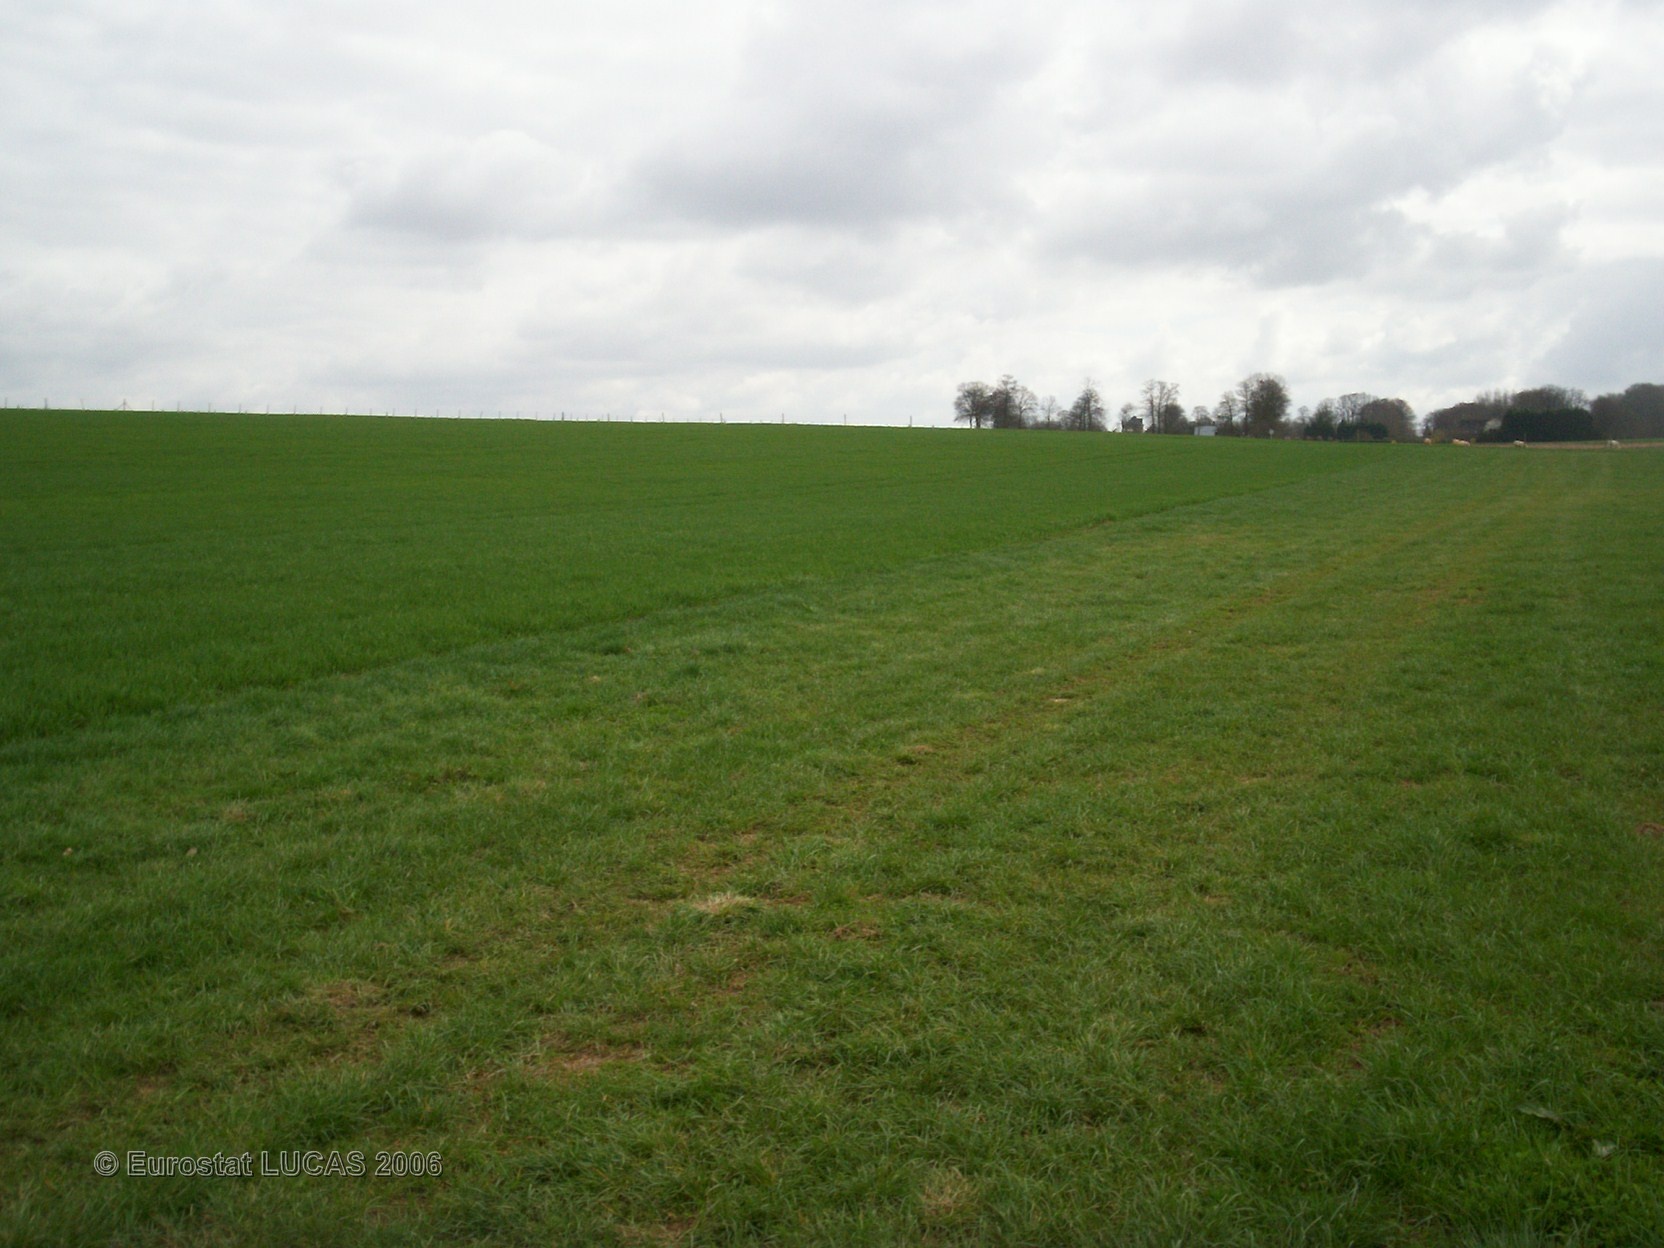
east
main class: Grassland
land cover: Grassland without tree/shrub cover
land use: Agriculture (excluding fallow land and kitchen gardens)
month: April
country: FR
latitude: 49.7306
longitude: 0.9173
